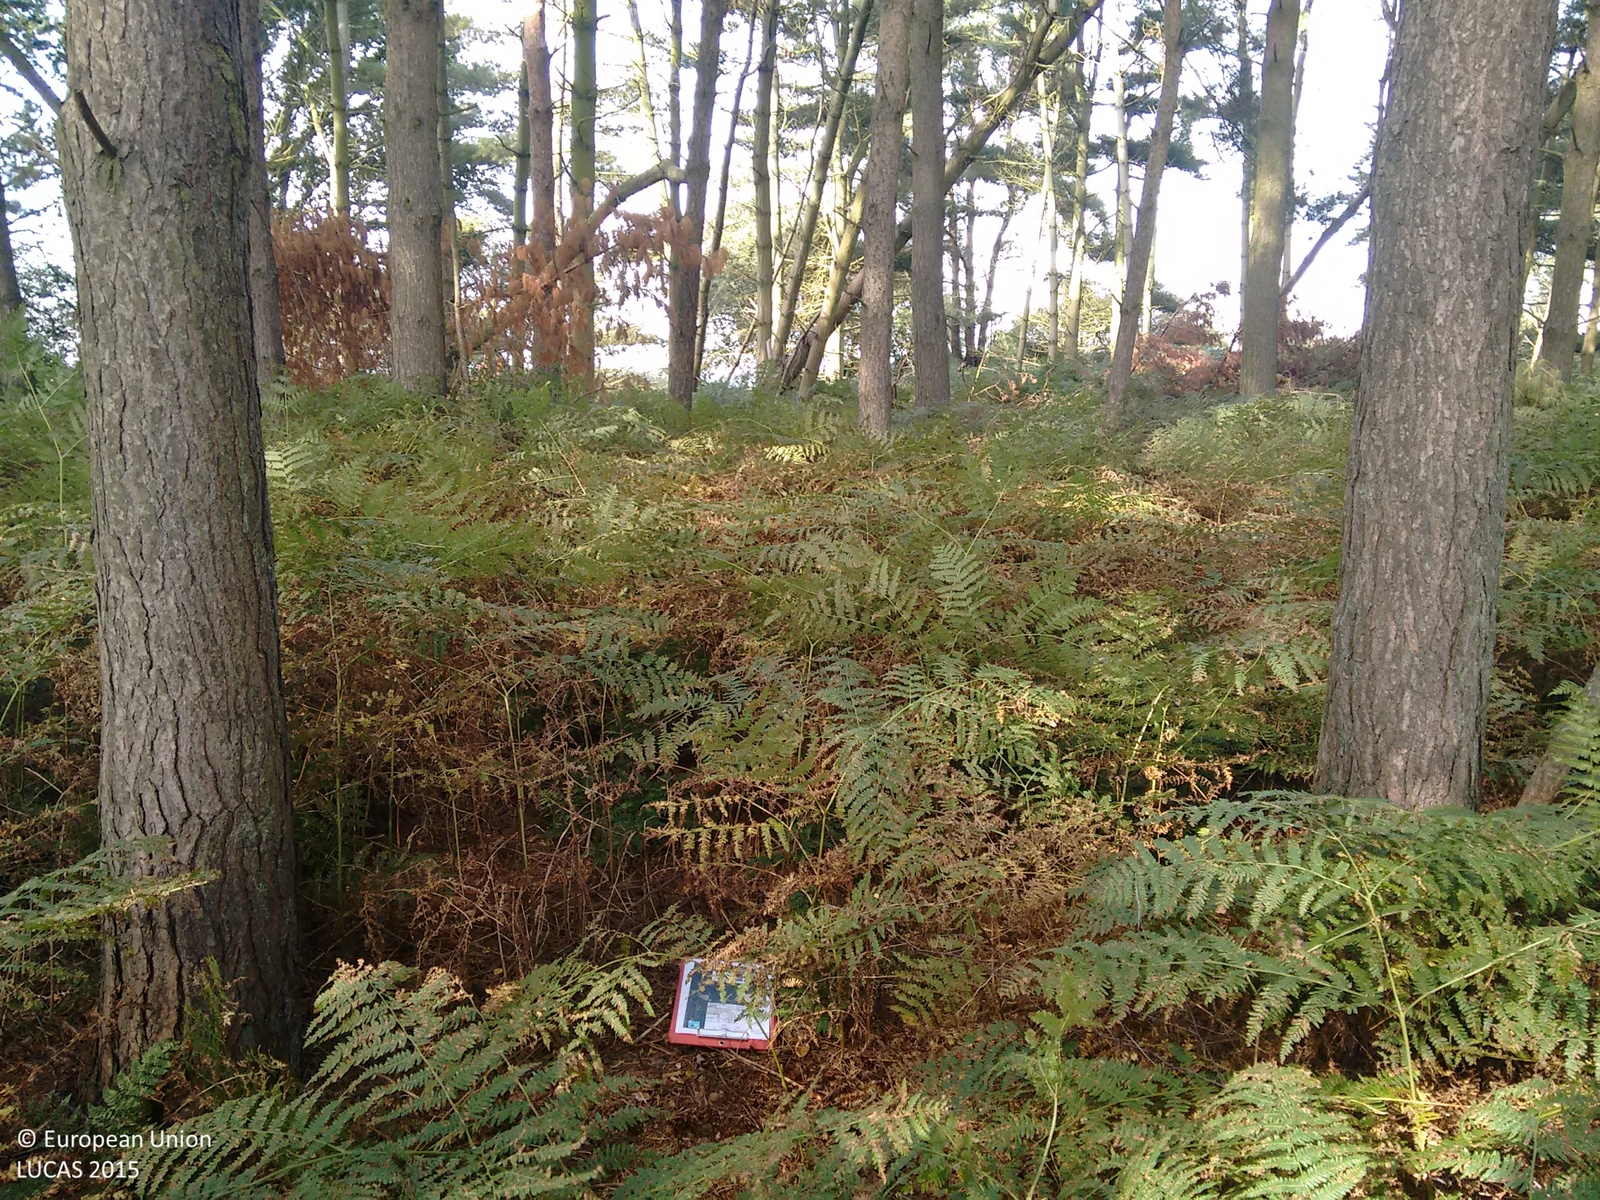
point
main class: Woodland
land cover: Pine dominated mixed woodland
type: exotic forest
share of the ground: > 75 %
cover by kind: coniferous forest trees 75 %, broadleaved forest trees 25 %
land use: Forestry
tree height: > 5 m
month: September
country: GB
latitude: 52.4568
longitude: 0.8367
